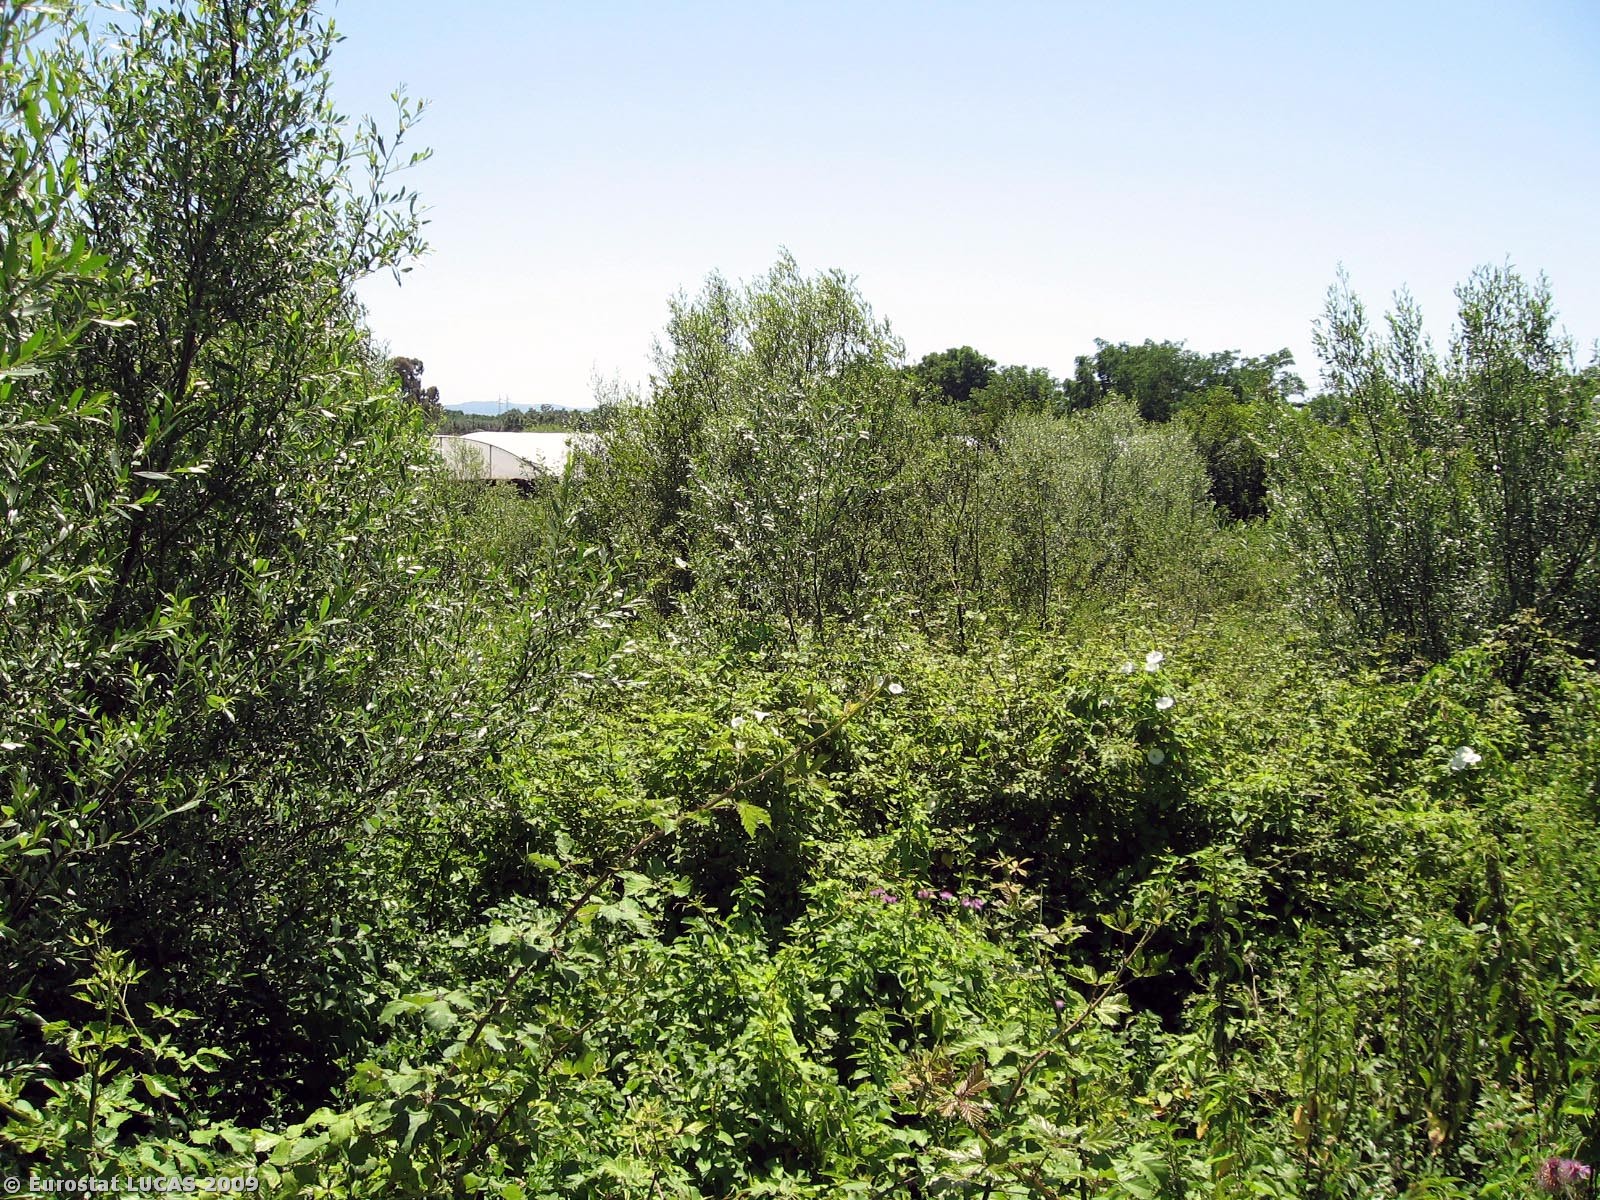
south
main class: Shrubland
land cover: Shrubland with sparse tree cover
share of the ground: > 75 %
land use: Unused
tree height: > 5 m
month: June
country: IT
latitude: 38.8499
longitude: 16.2693
